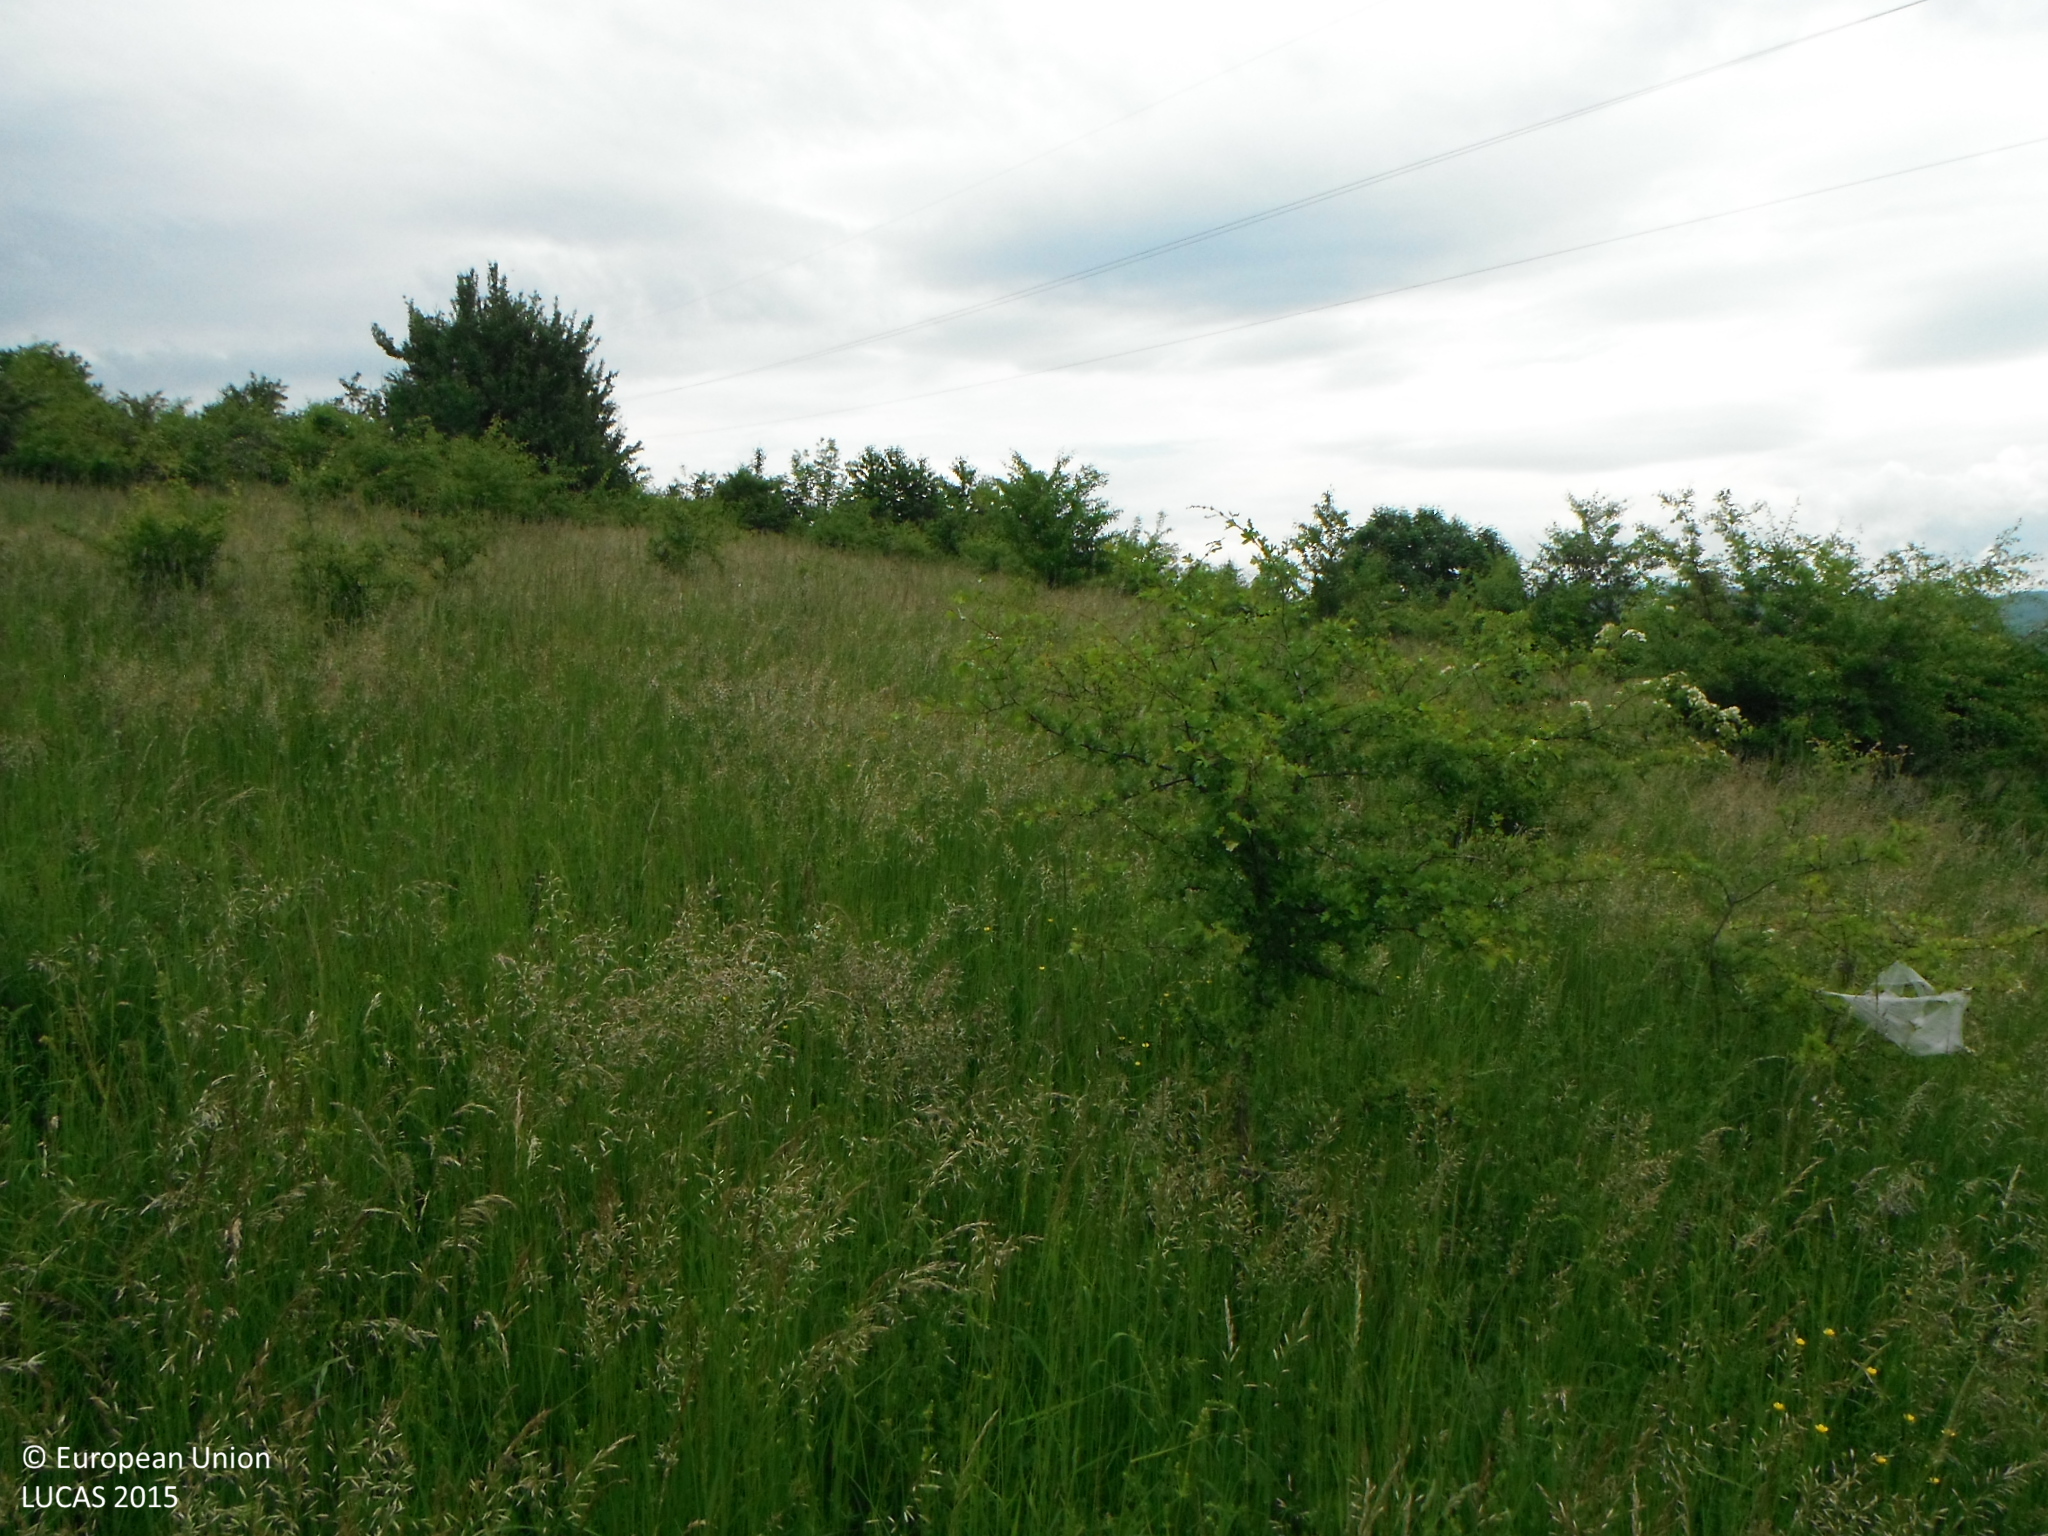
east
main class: Grassland
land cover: Grassland with sparse tree/shrub cover
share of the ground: > 75 %
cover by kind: herbaceous plants 85 %, shrubs 10 %, broadleaved forest trees 5 %
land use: Agriculture (excluding fallow land and kitchen gardens)
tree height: < 5 m
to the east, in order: Grassland with sparse tree/shrub cover; Shrubland without tree cover; Shrubland with sparse tree cover; Electric lines; Shrubland with sparse tree cover; Grassland without tree/shrub cover; Shrubland with sparse tree cover; Grassland with sparse tree/shrub cover; Shrubland with sparse tree cover; Spontaneously vegetated surfaces; Grassland without tree/shrub cover; Shrubland with sparse tree cover; Tracks; Shrubland without tree cover
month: May
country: SK
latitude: 48.7456
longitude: 19.1751
